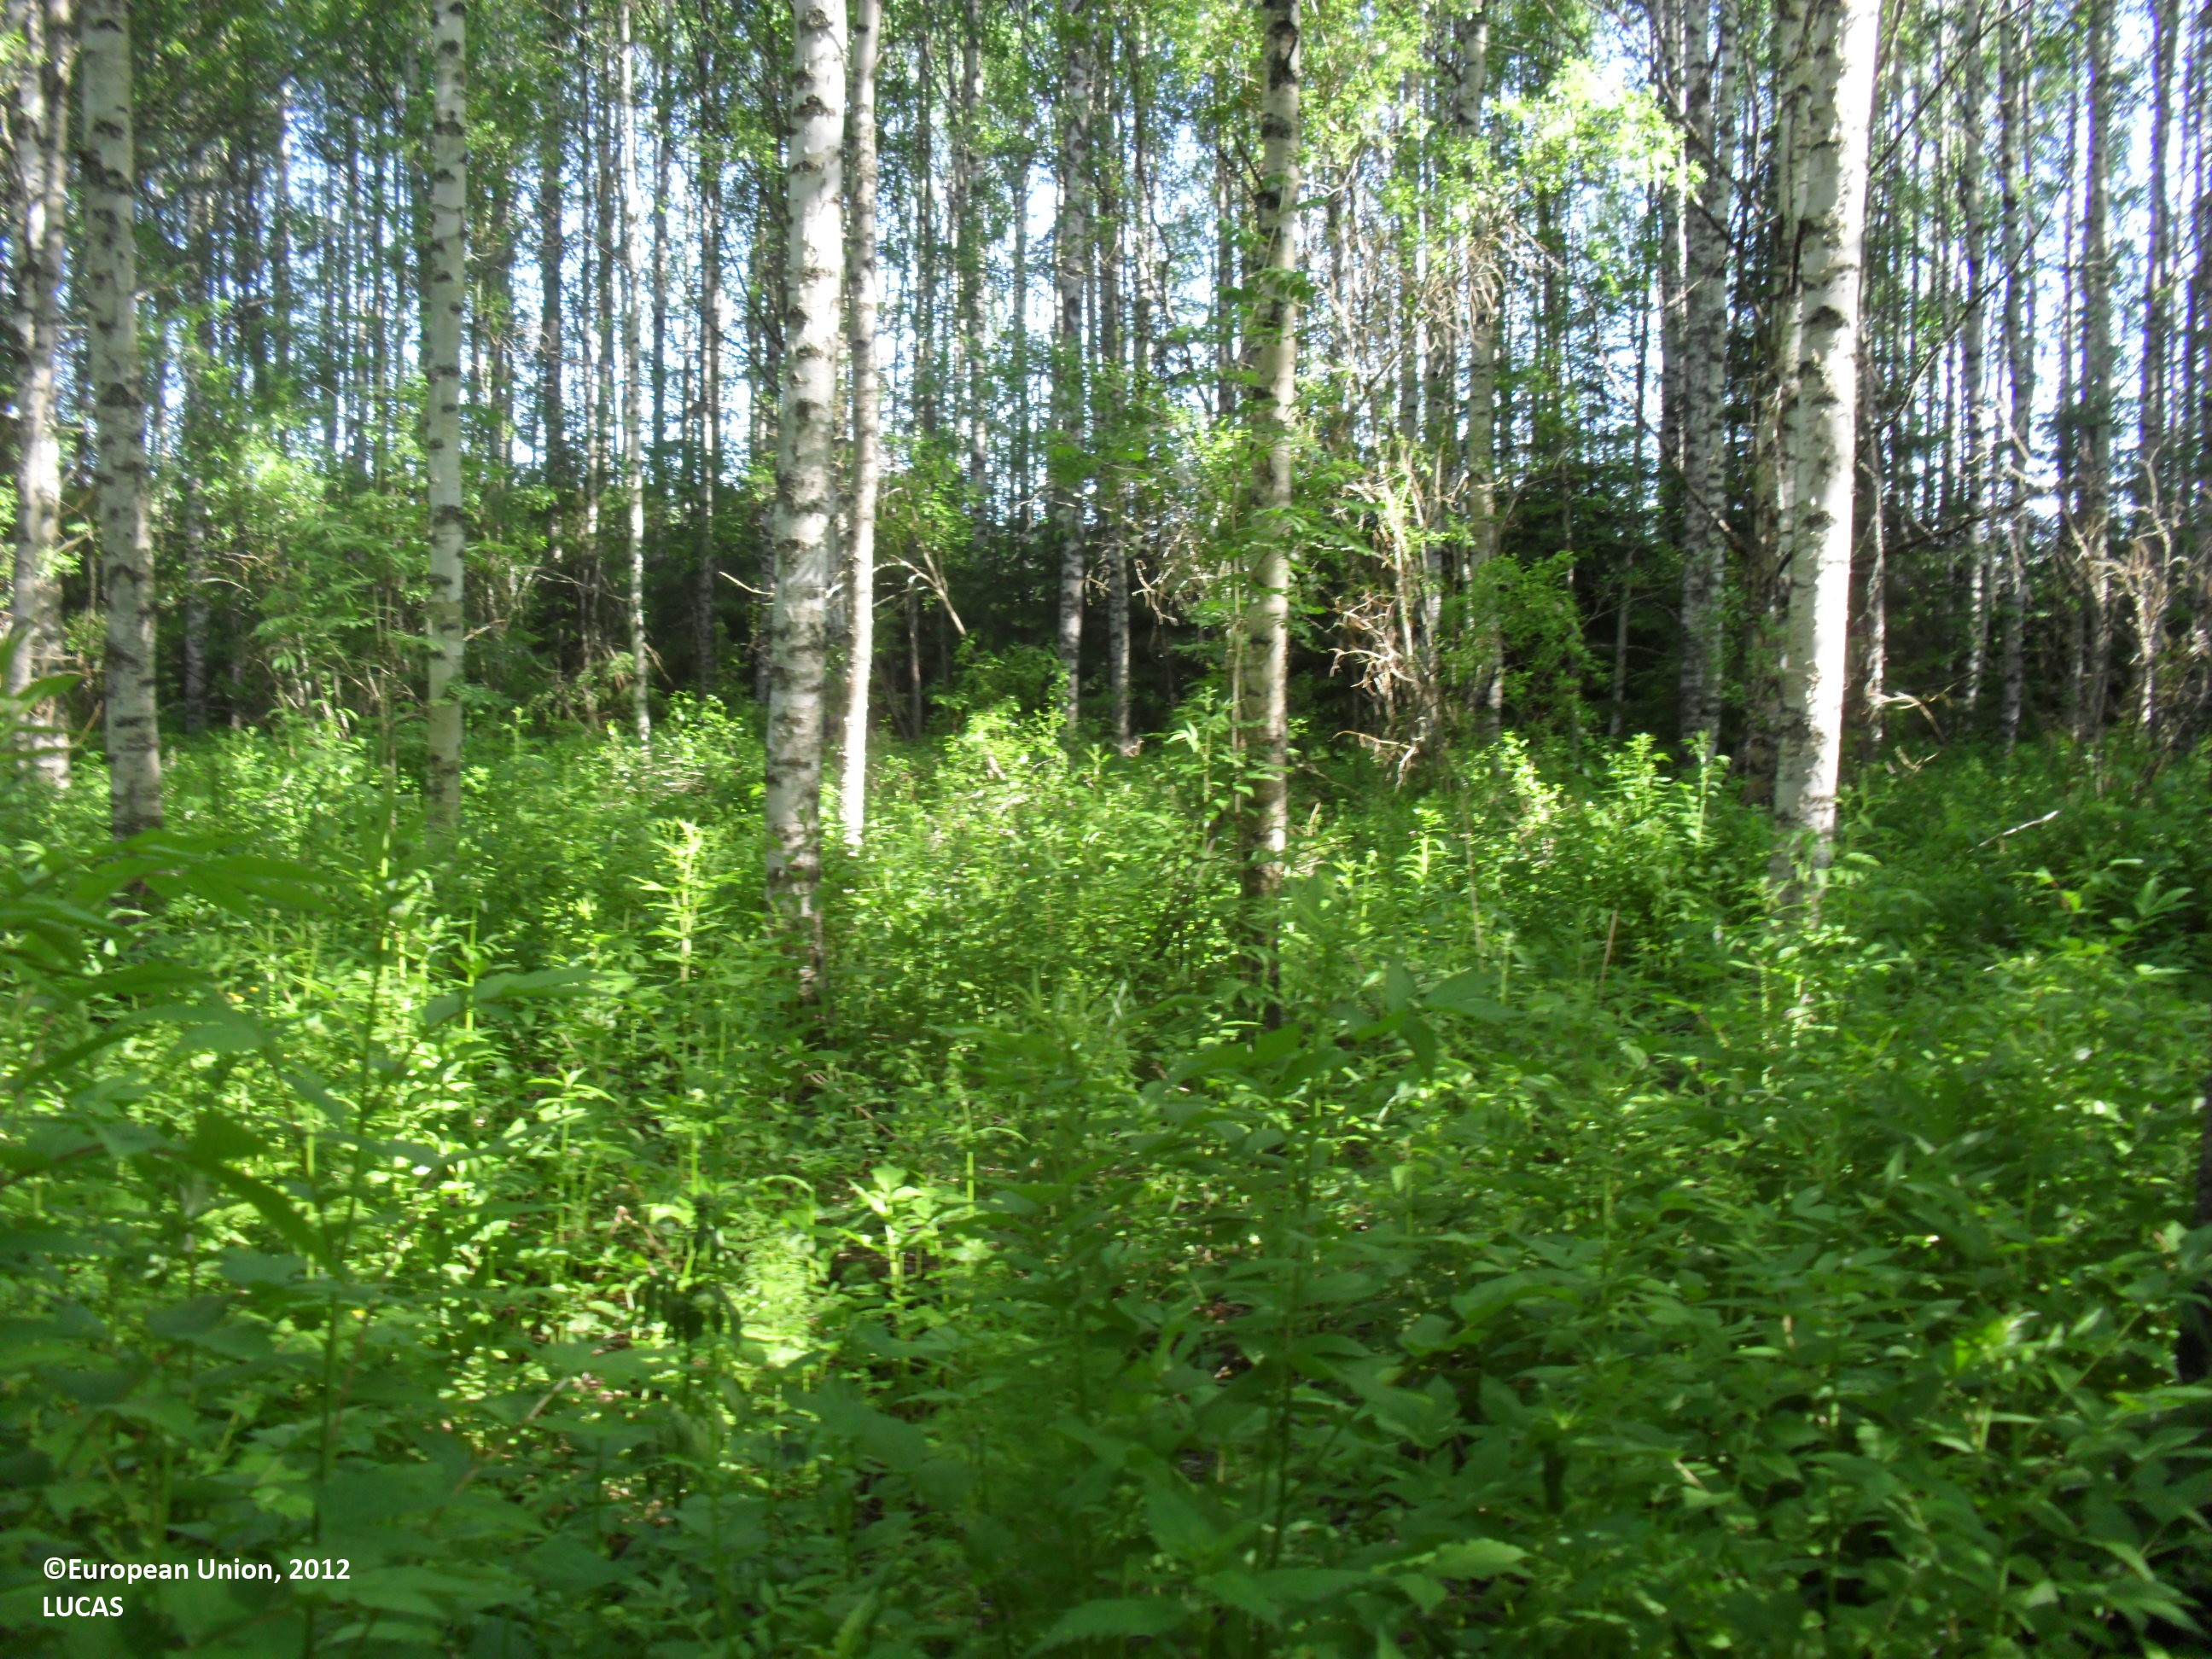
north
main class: Woodland
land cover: Broadleaved woodland
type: boreal forest
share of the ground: 50 - 75 %
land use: Forestry
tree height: > 5 m
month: June
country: FI
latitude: 63.1298
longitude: 22.9675
